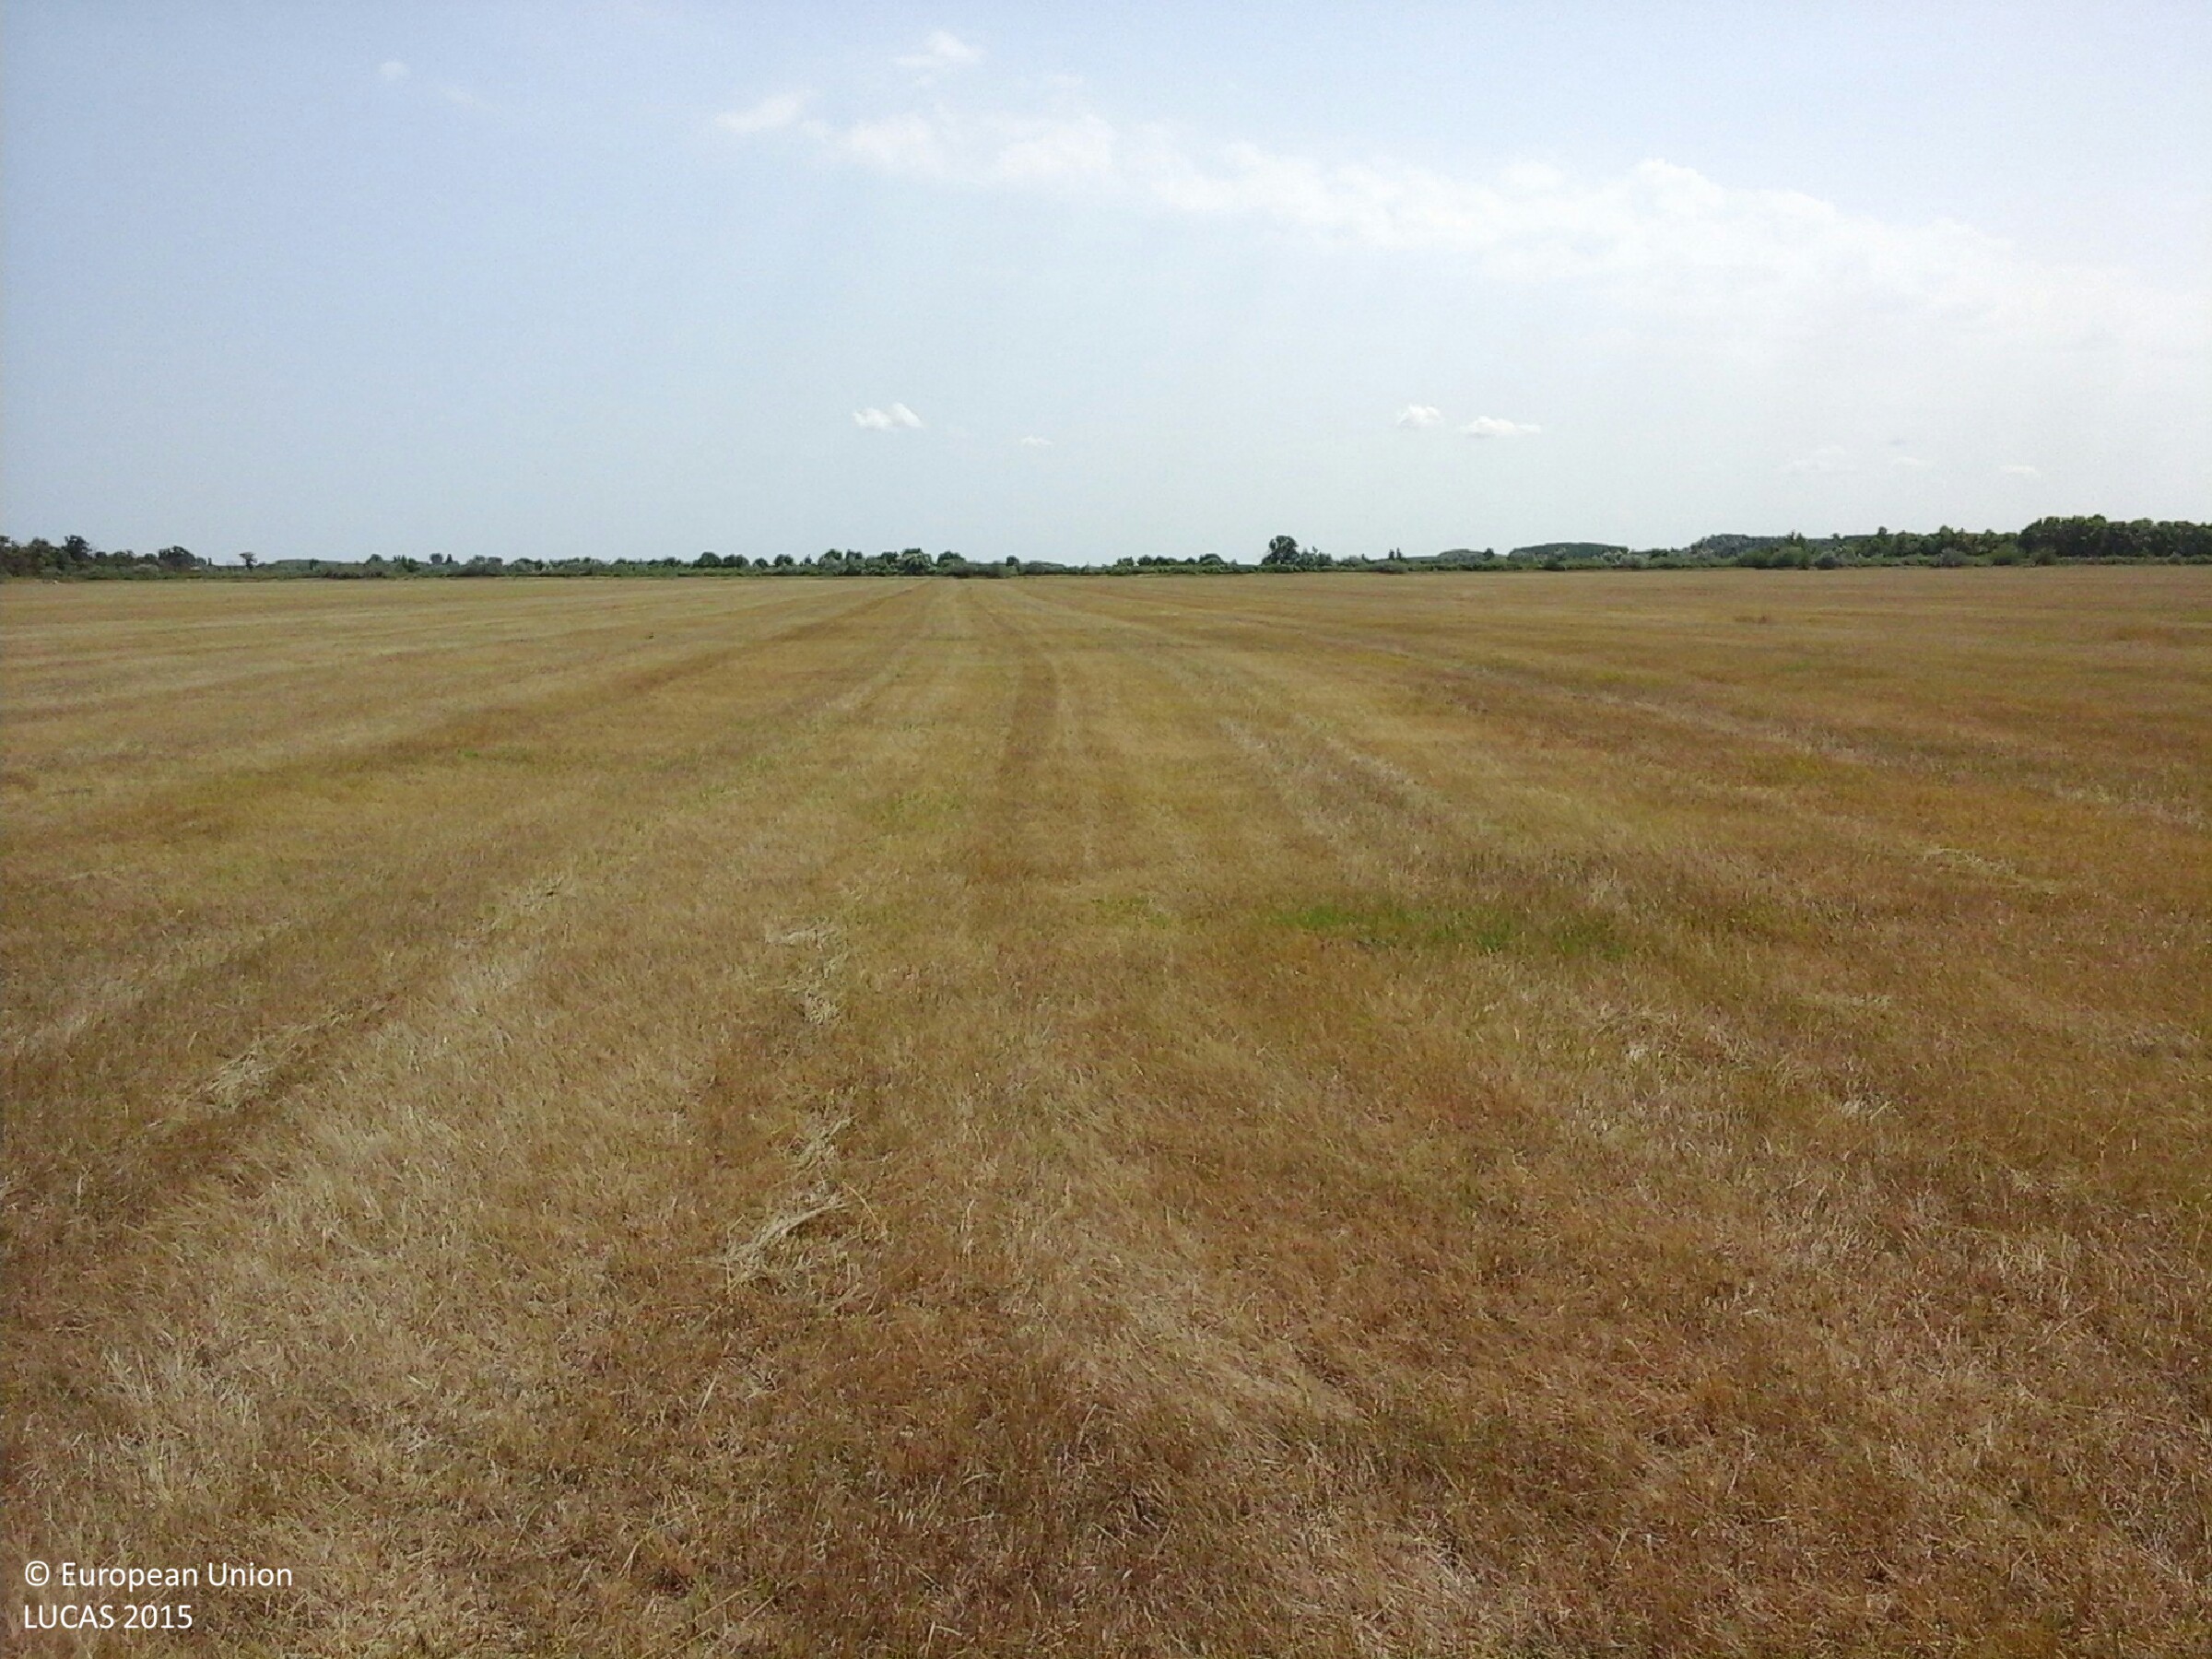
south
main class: Grassland
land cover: Grassland without tree/shrub cover
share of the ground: > 75 %
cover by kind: herbaceous plants 100 %
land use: Agriculture (excluding fallow land and kitchen gardens)
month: July
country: HU
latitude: 47.4566
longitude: 20.6036
